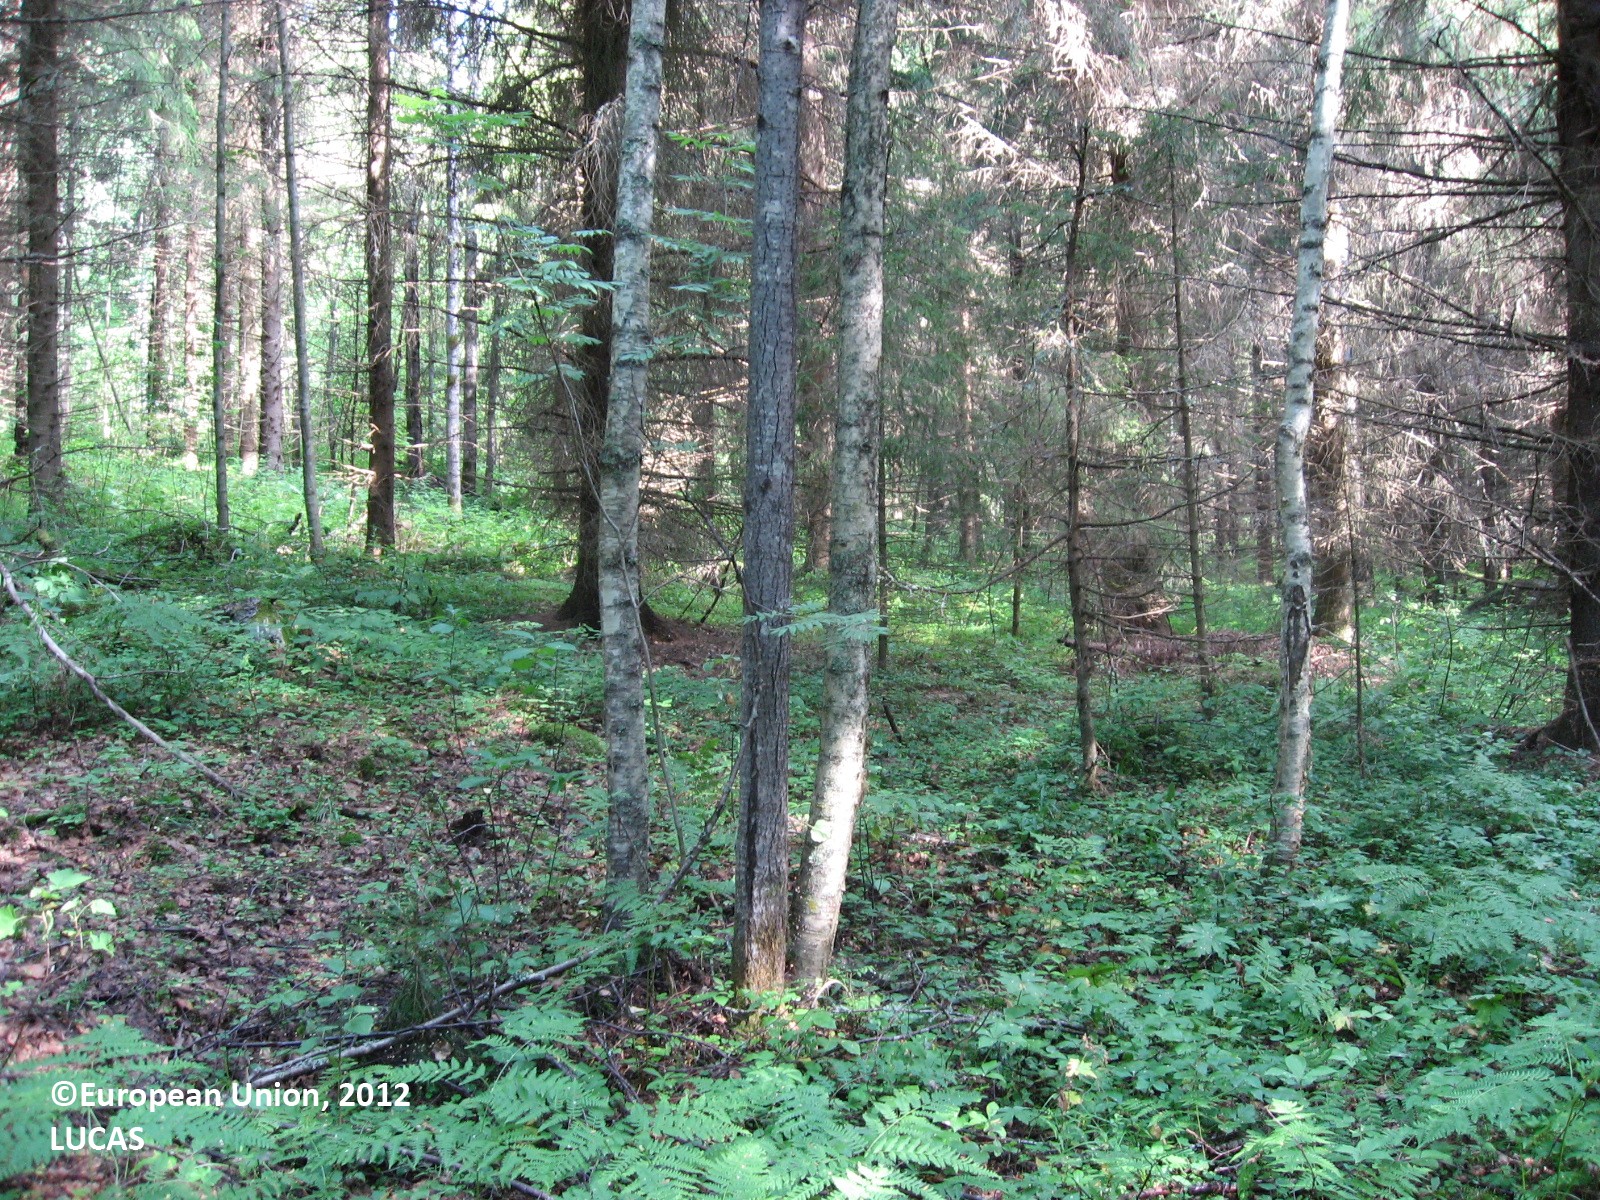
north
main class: Woodland
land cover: Spruce dominated coniferous woodland
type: boreal forest
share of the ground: > 75 %
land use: Forestry
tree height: > 5 m
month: August
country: FI
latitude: 61.5403
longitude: 25.8750
